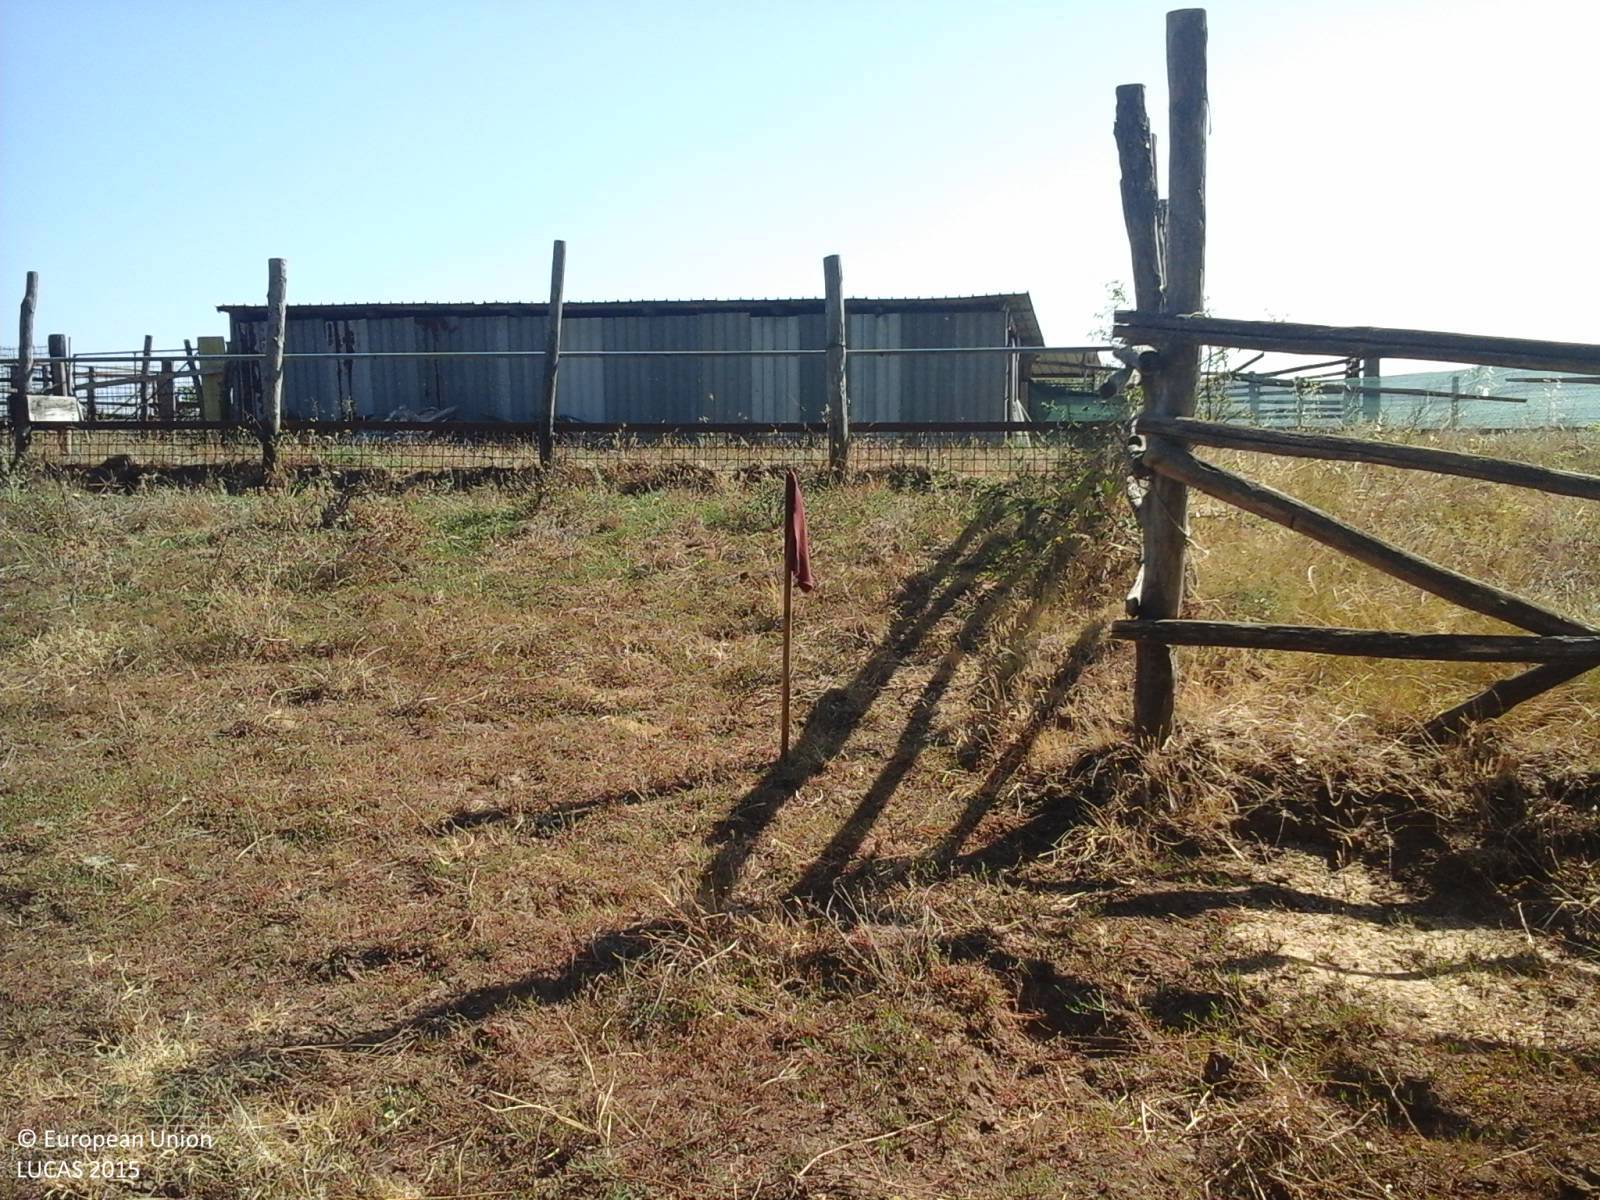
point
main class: Grassland
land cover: Grassland without tree/shrub cover
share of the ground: > 75 %
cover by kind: herbaceous plants 55 %, unconsolidated bare surface 45 %
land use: Agriculture (excluding fallow land and kitchen gardens)
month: July
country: IT
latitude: 42.1889
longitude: 12.5218
